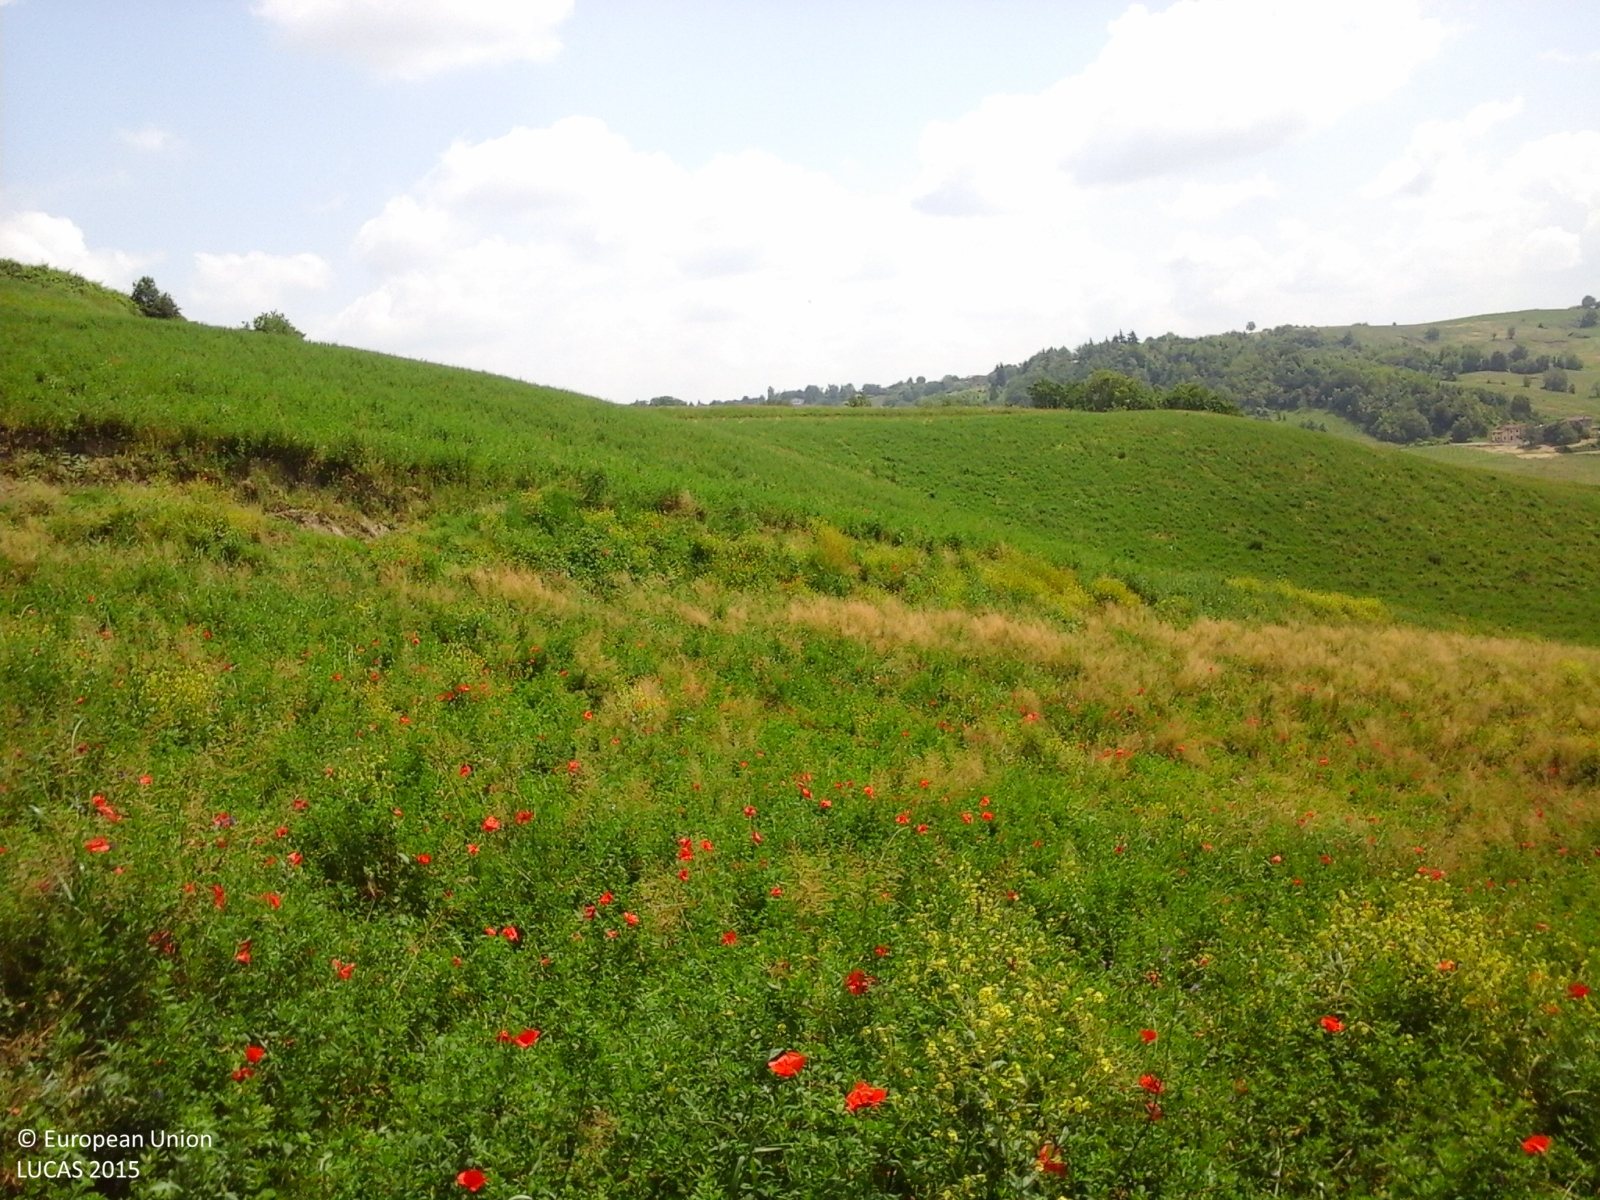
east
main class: Cropland
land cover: Lucerne
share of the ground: > 75 %
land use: Agriculture (excluding fallow land and kitchen gardens)
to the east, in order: Lucerne; Managed hedges; Grassland without tree/shrub cover
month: May
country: IT
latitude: 44.6569
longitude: 10.2391
